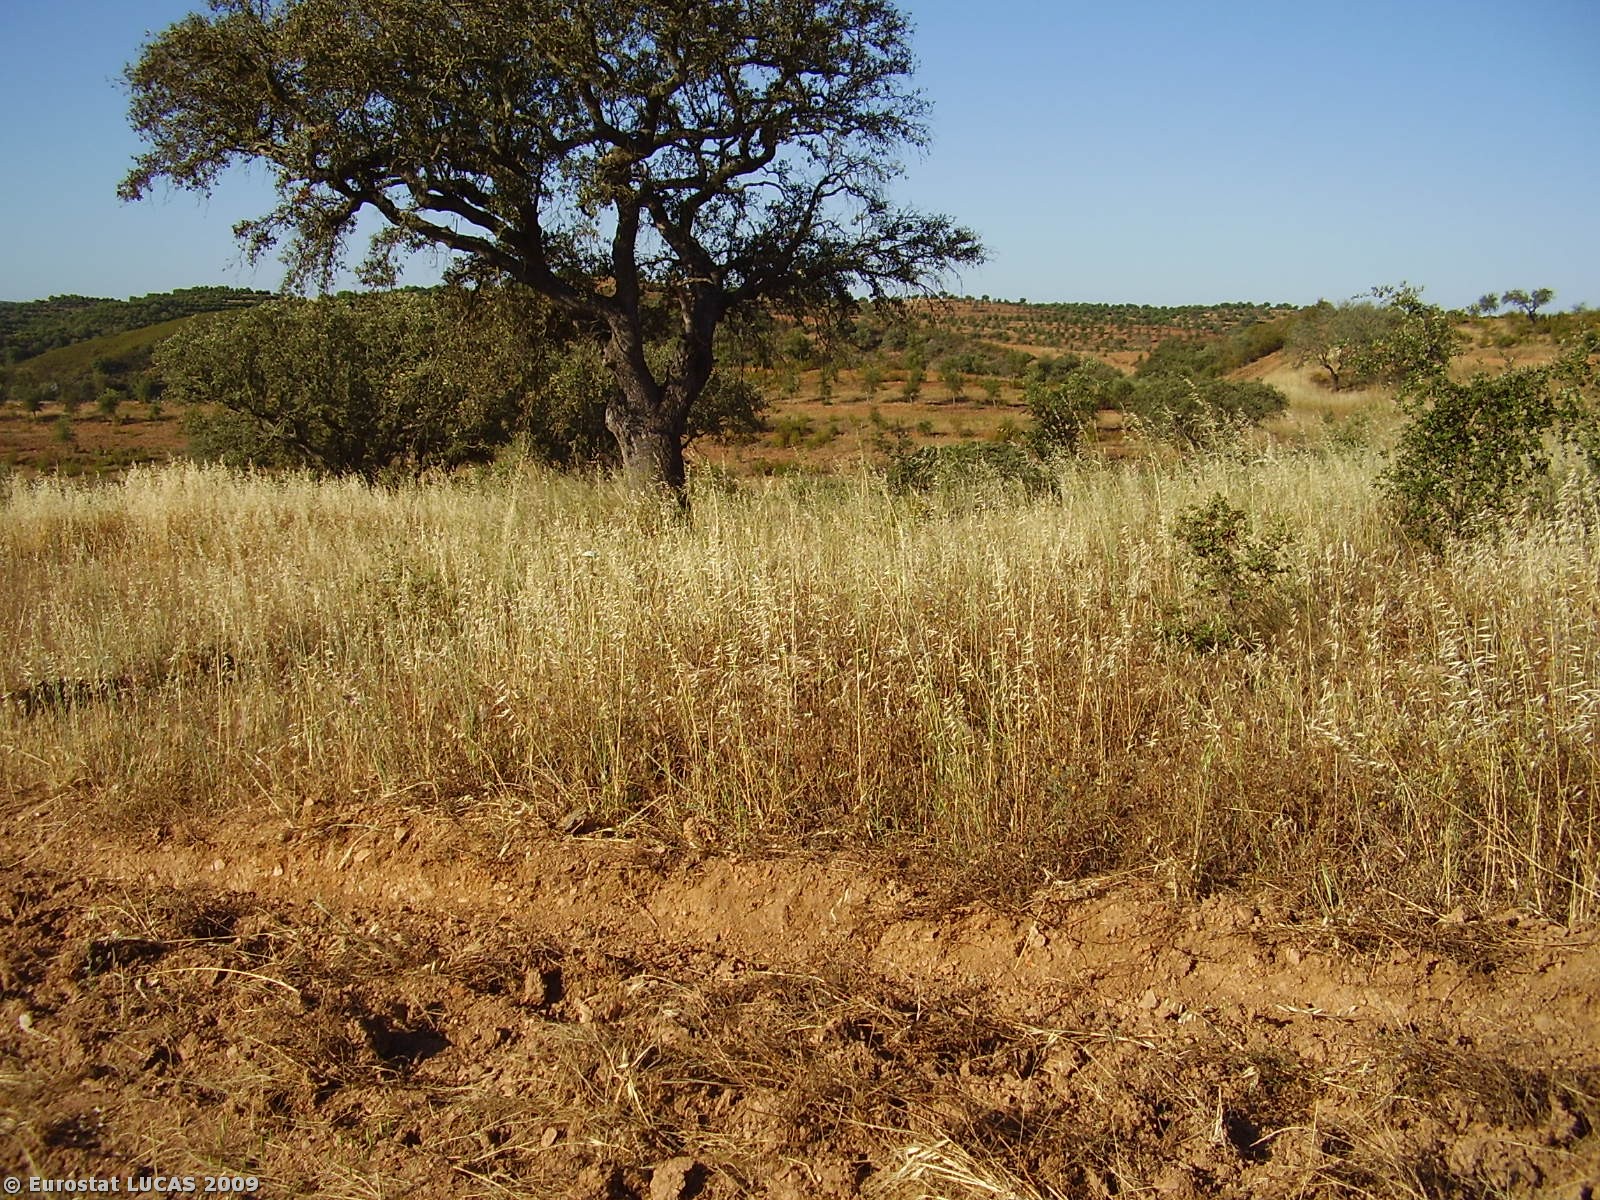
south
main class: Woodland
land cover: Broadleaved woodland
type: broadleaved evergreen forest
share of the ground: 10 - 25 %
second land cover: Spontaneously vegetated surfaces
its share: > 75 %
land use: Forestry
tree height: > 5 m
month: May
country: PT
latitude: 37.7806
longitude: -7.7674
